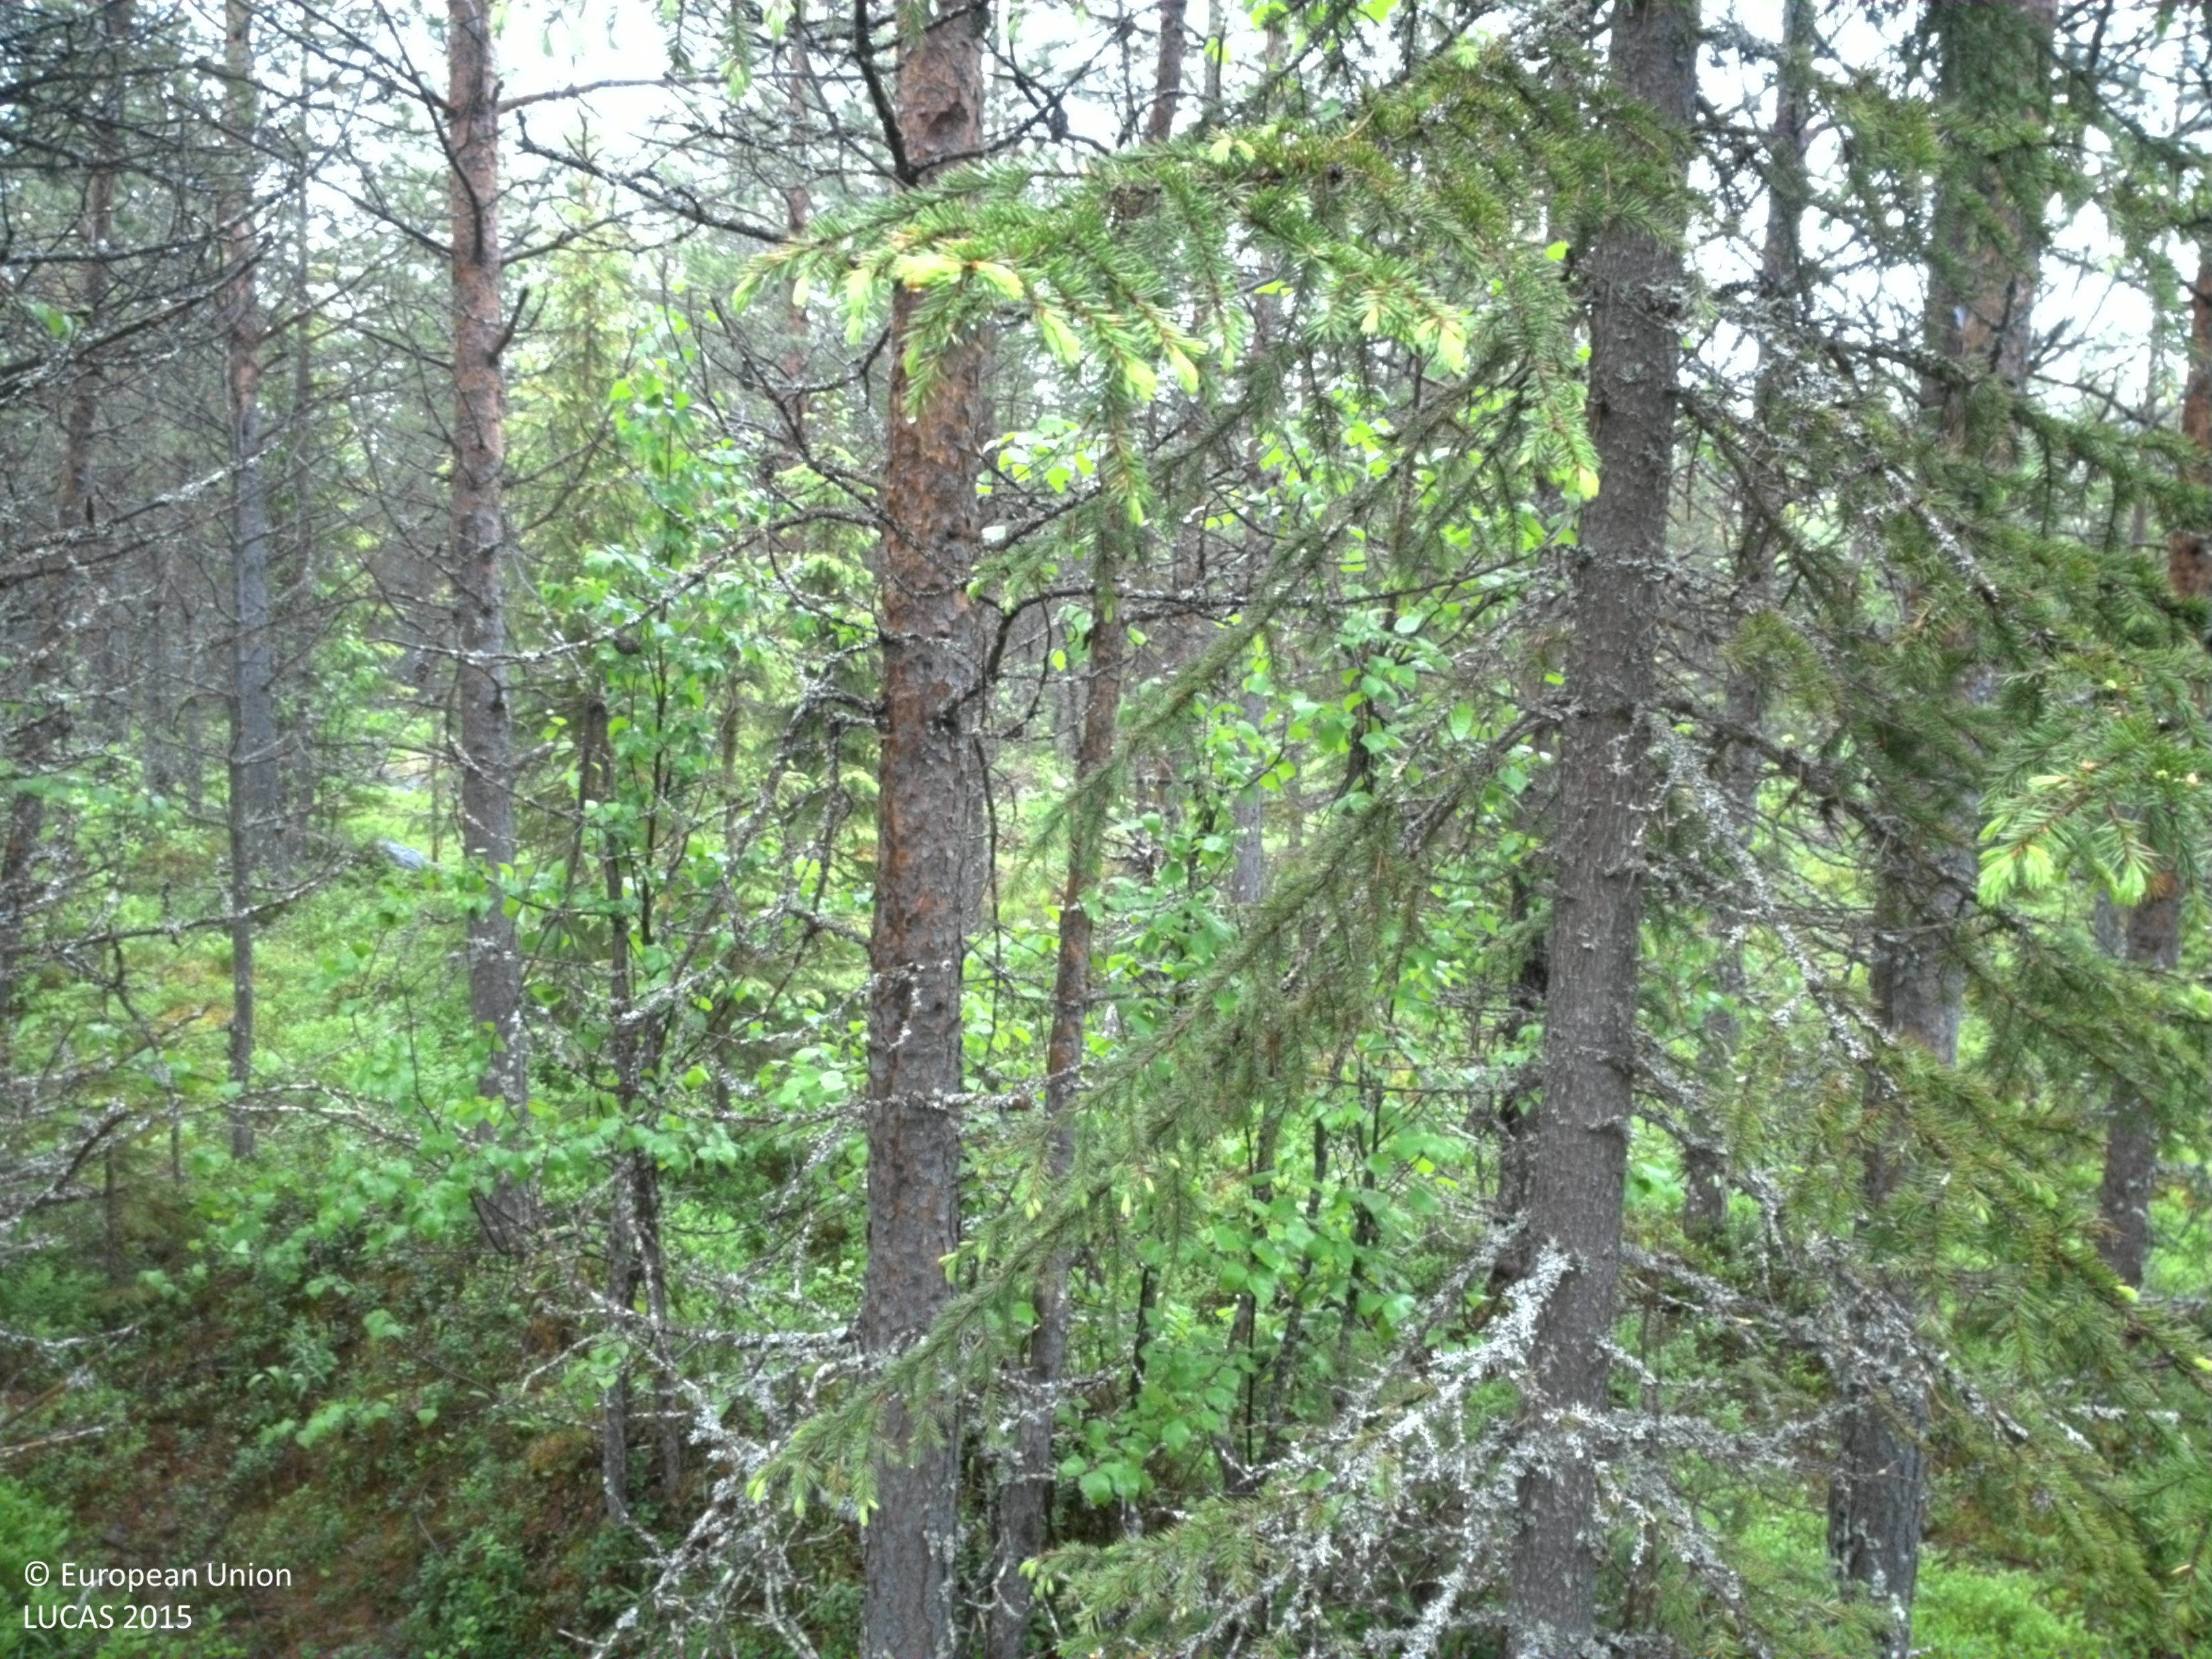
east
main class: Woodland
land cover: Pine dominated coniferous woodland
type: boreal forest
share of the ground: 25 - 50 %
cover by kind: shrubs 55 %, coniferous forest trees 40 %, broadleaved forest trees 5 %
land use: Forestry
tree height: > 5 m
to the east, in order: Pine dominated coniferous woodland
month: June
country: SE
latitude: 66.5566
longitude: 22.8365
